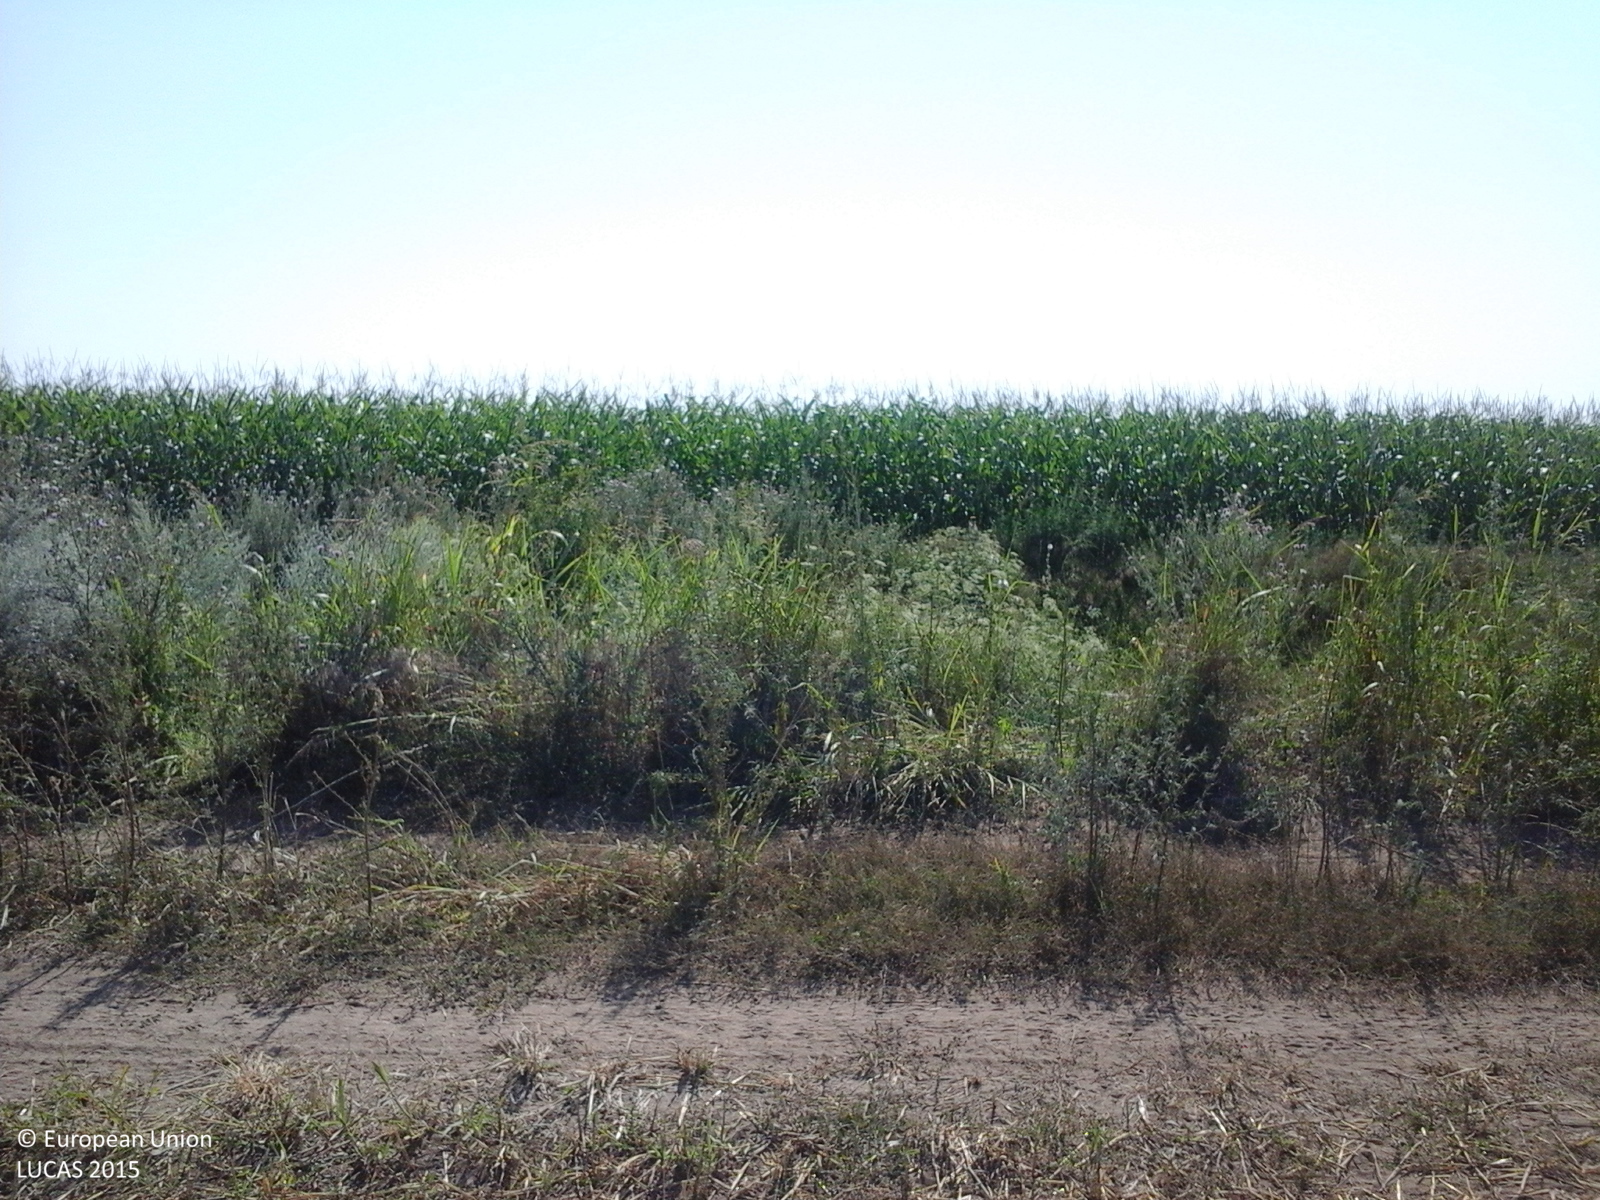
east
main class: Cropland
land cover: Common wheat
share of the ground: 10 - 25 %
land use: Agriculture (excluding fallow land and kitchen gardens)
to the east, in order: Common wheat; Tracks; Grass margins; Ditches and canals; Grass margins; Maize
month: July
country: RO
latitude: 44.3035
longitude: 27.3984
